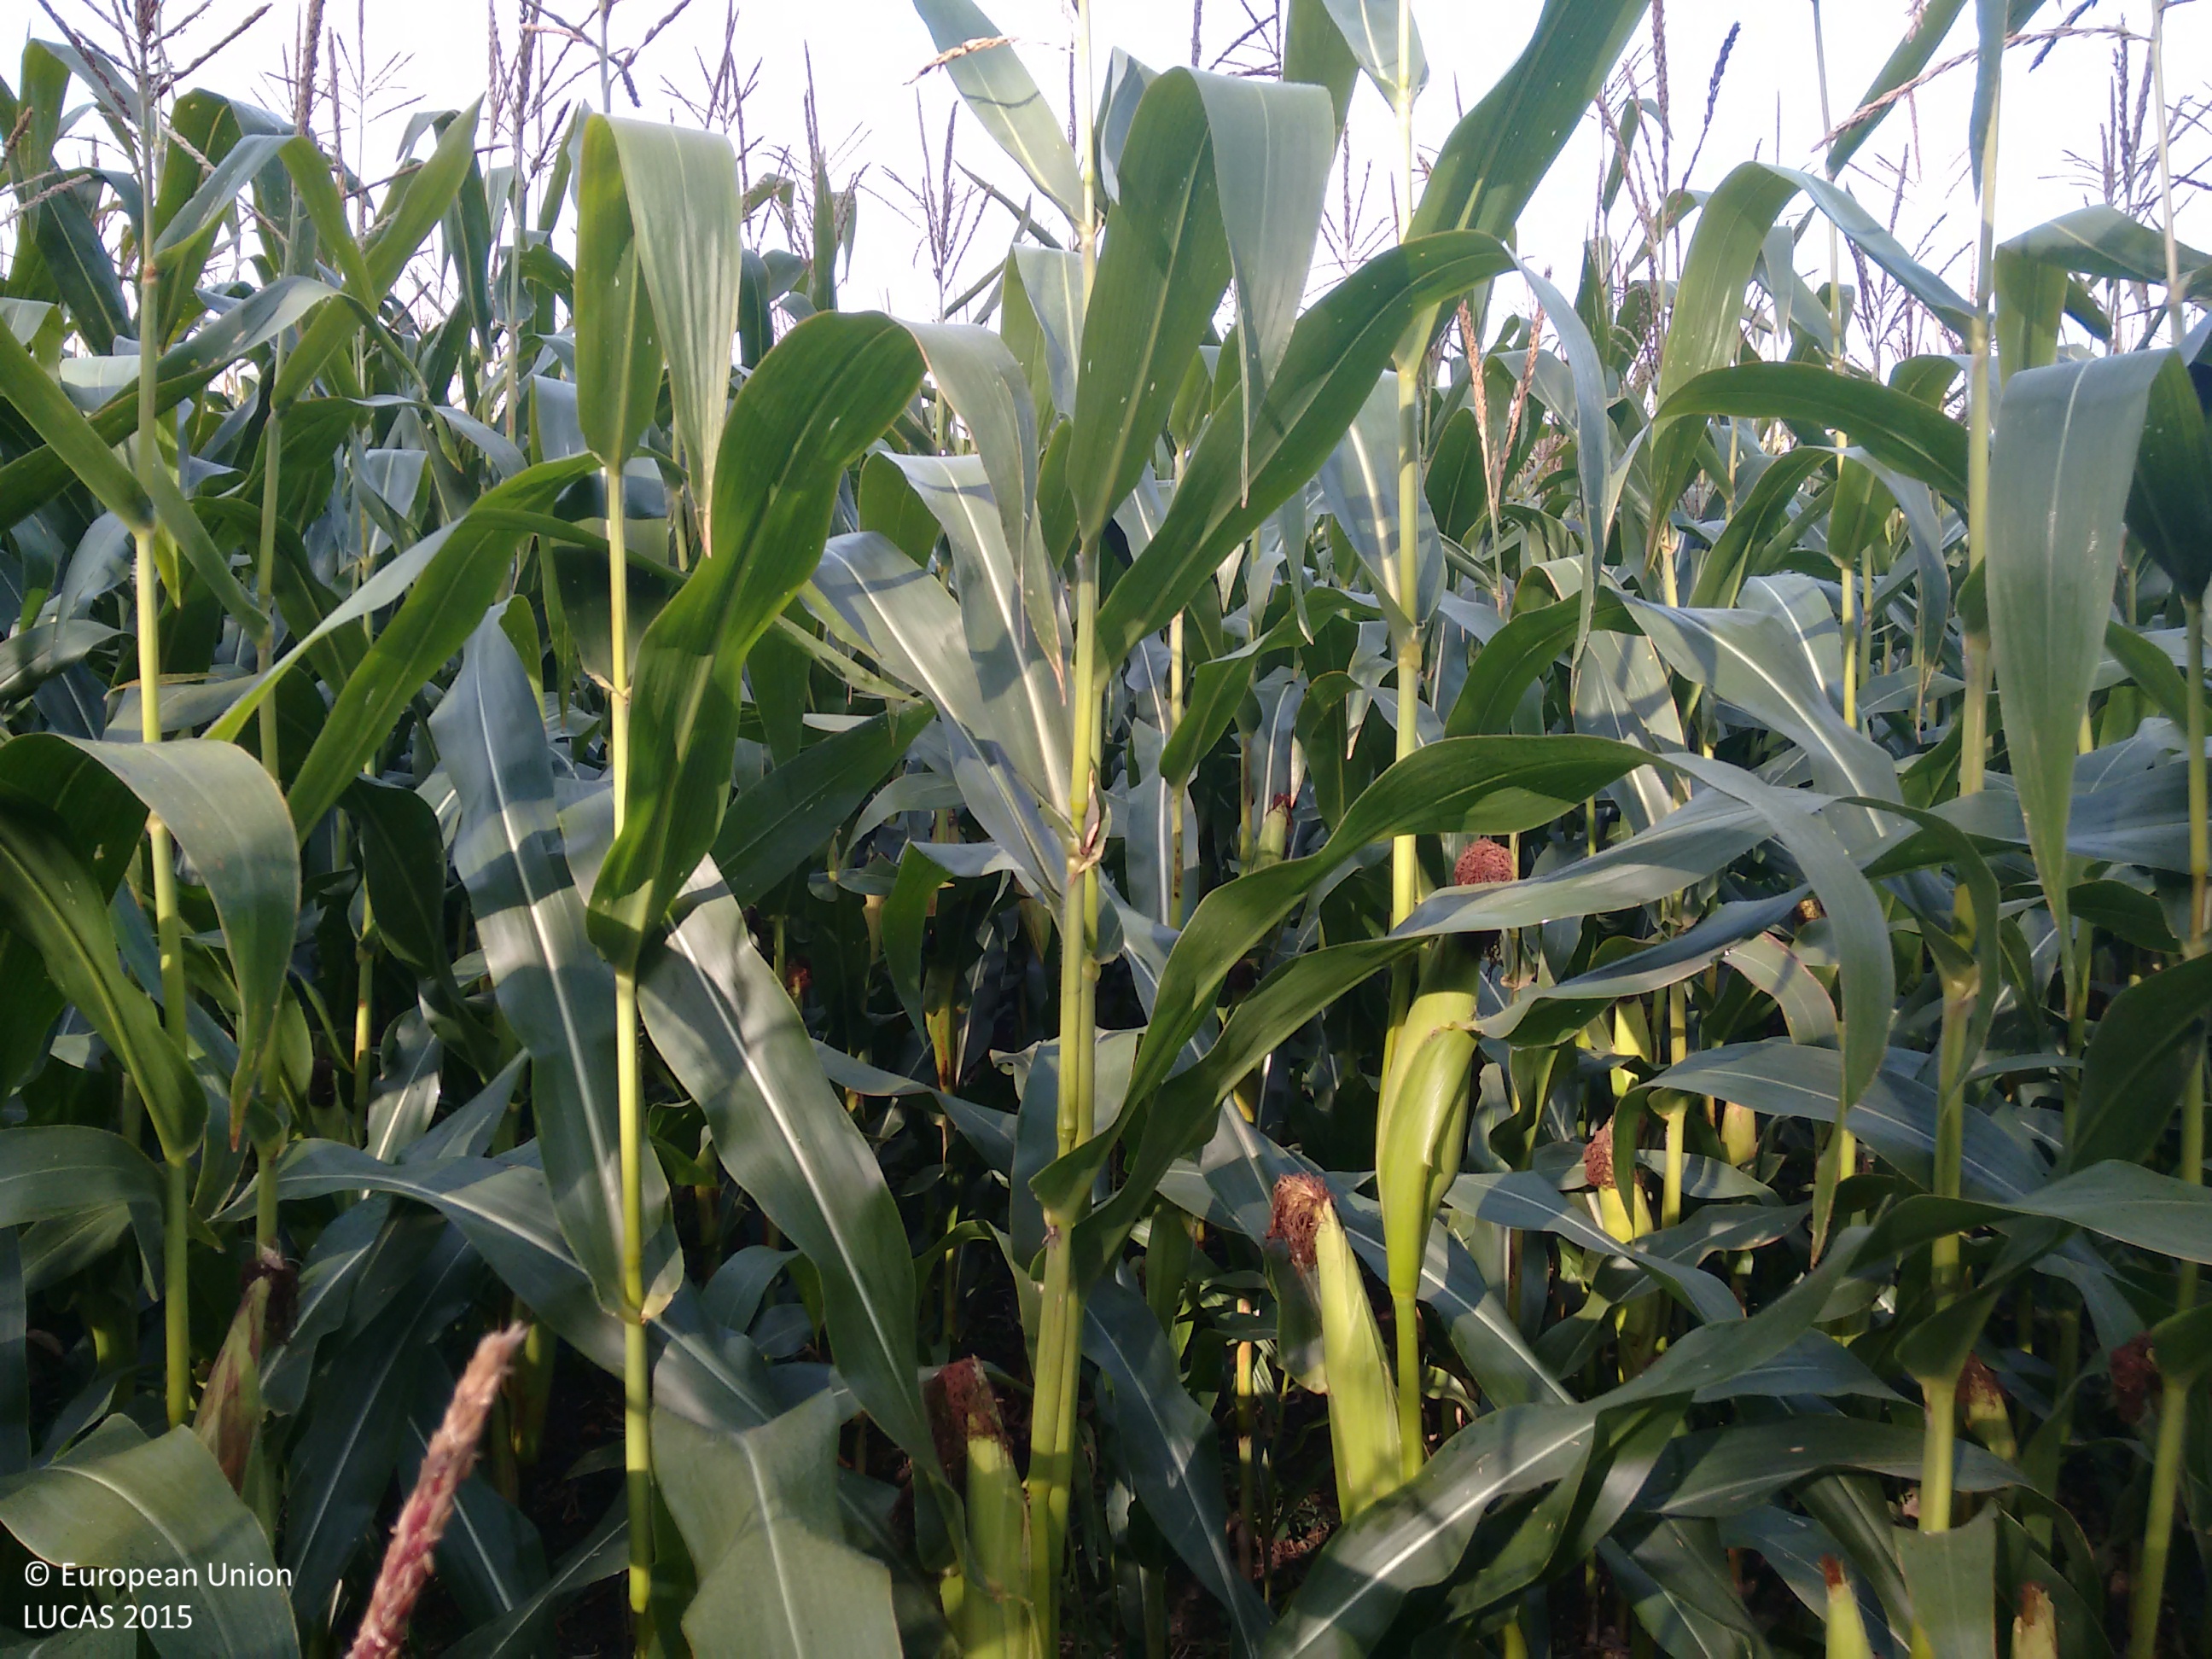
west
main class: Cropland
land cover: Arable land (only in case pi)
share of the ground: > 75 %
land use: Agriculture (excluding fallow land and kitchen gardens)
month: September
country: GB
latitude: 51.8797
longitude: -2.1323
